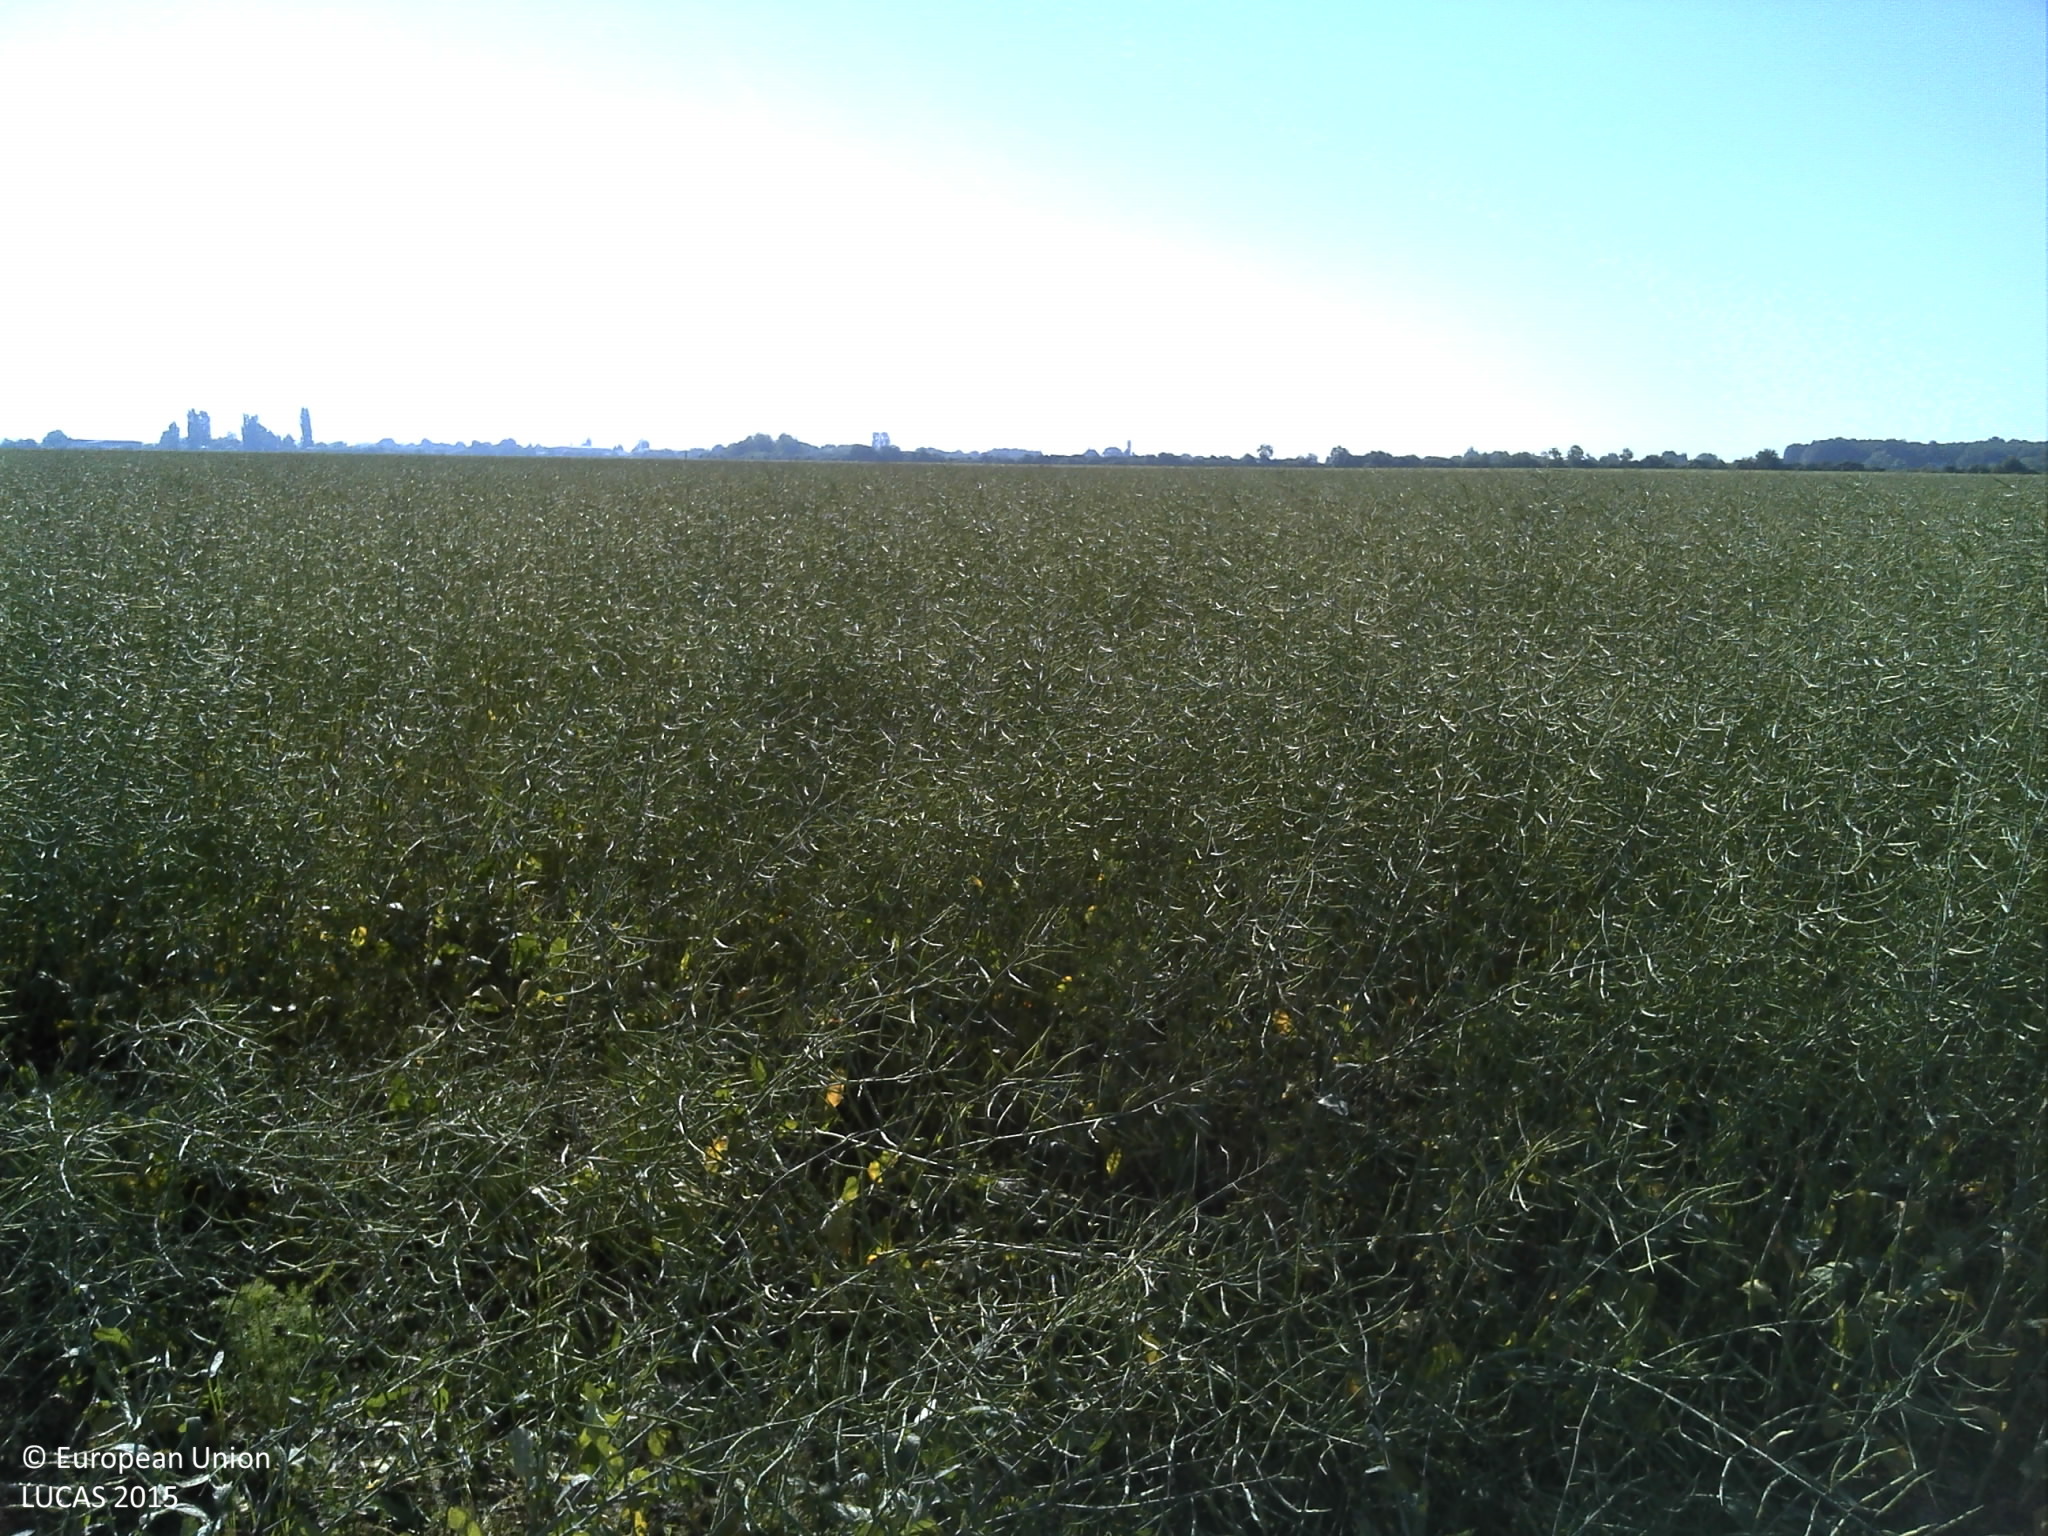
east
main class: Cropland
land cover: Rape and turnip rape
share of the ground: > 75 %
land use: Agriculture (excluding fallow land and kitchen gardens)
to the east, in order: Rape and turnip rape; Common wheat
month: May
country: HR
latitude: 45.5694
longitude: 17.9094
